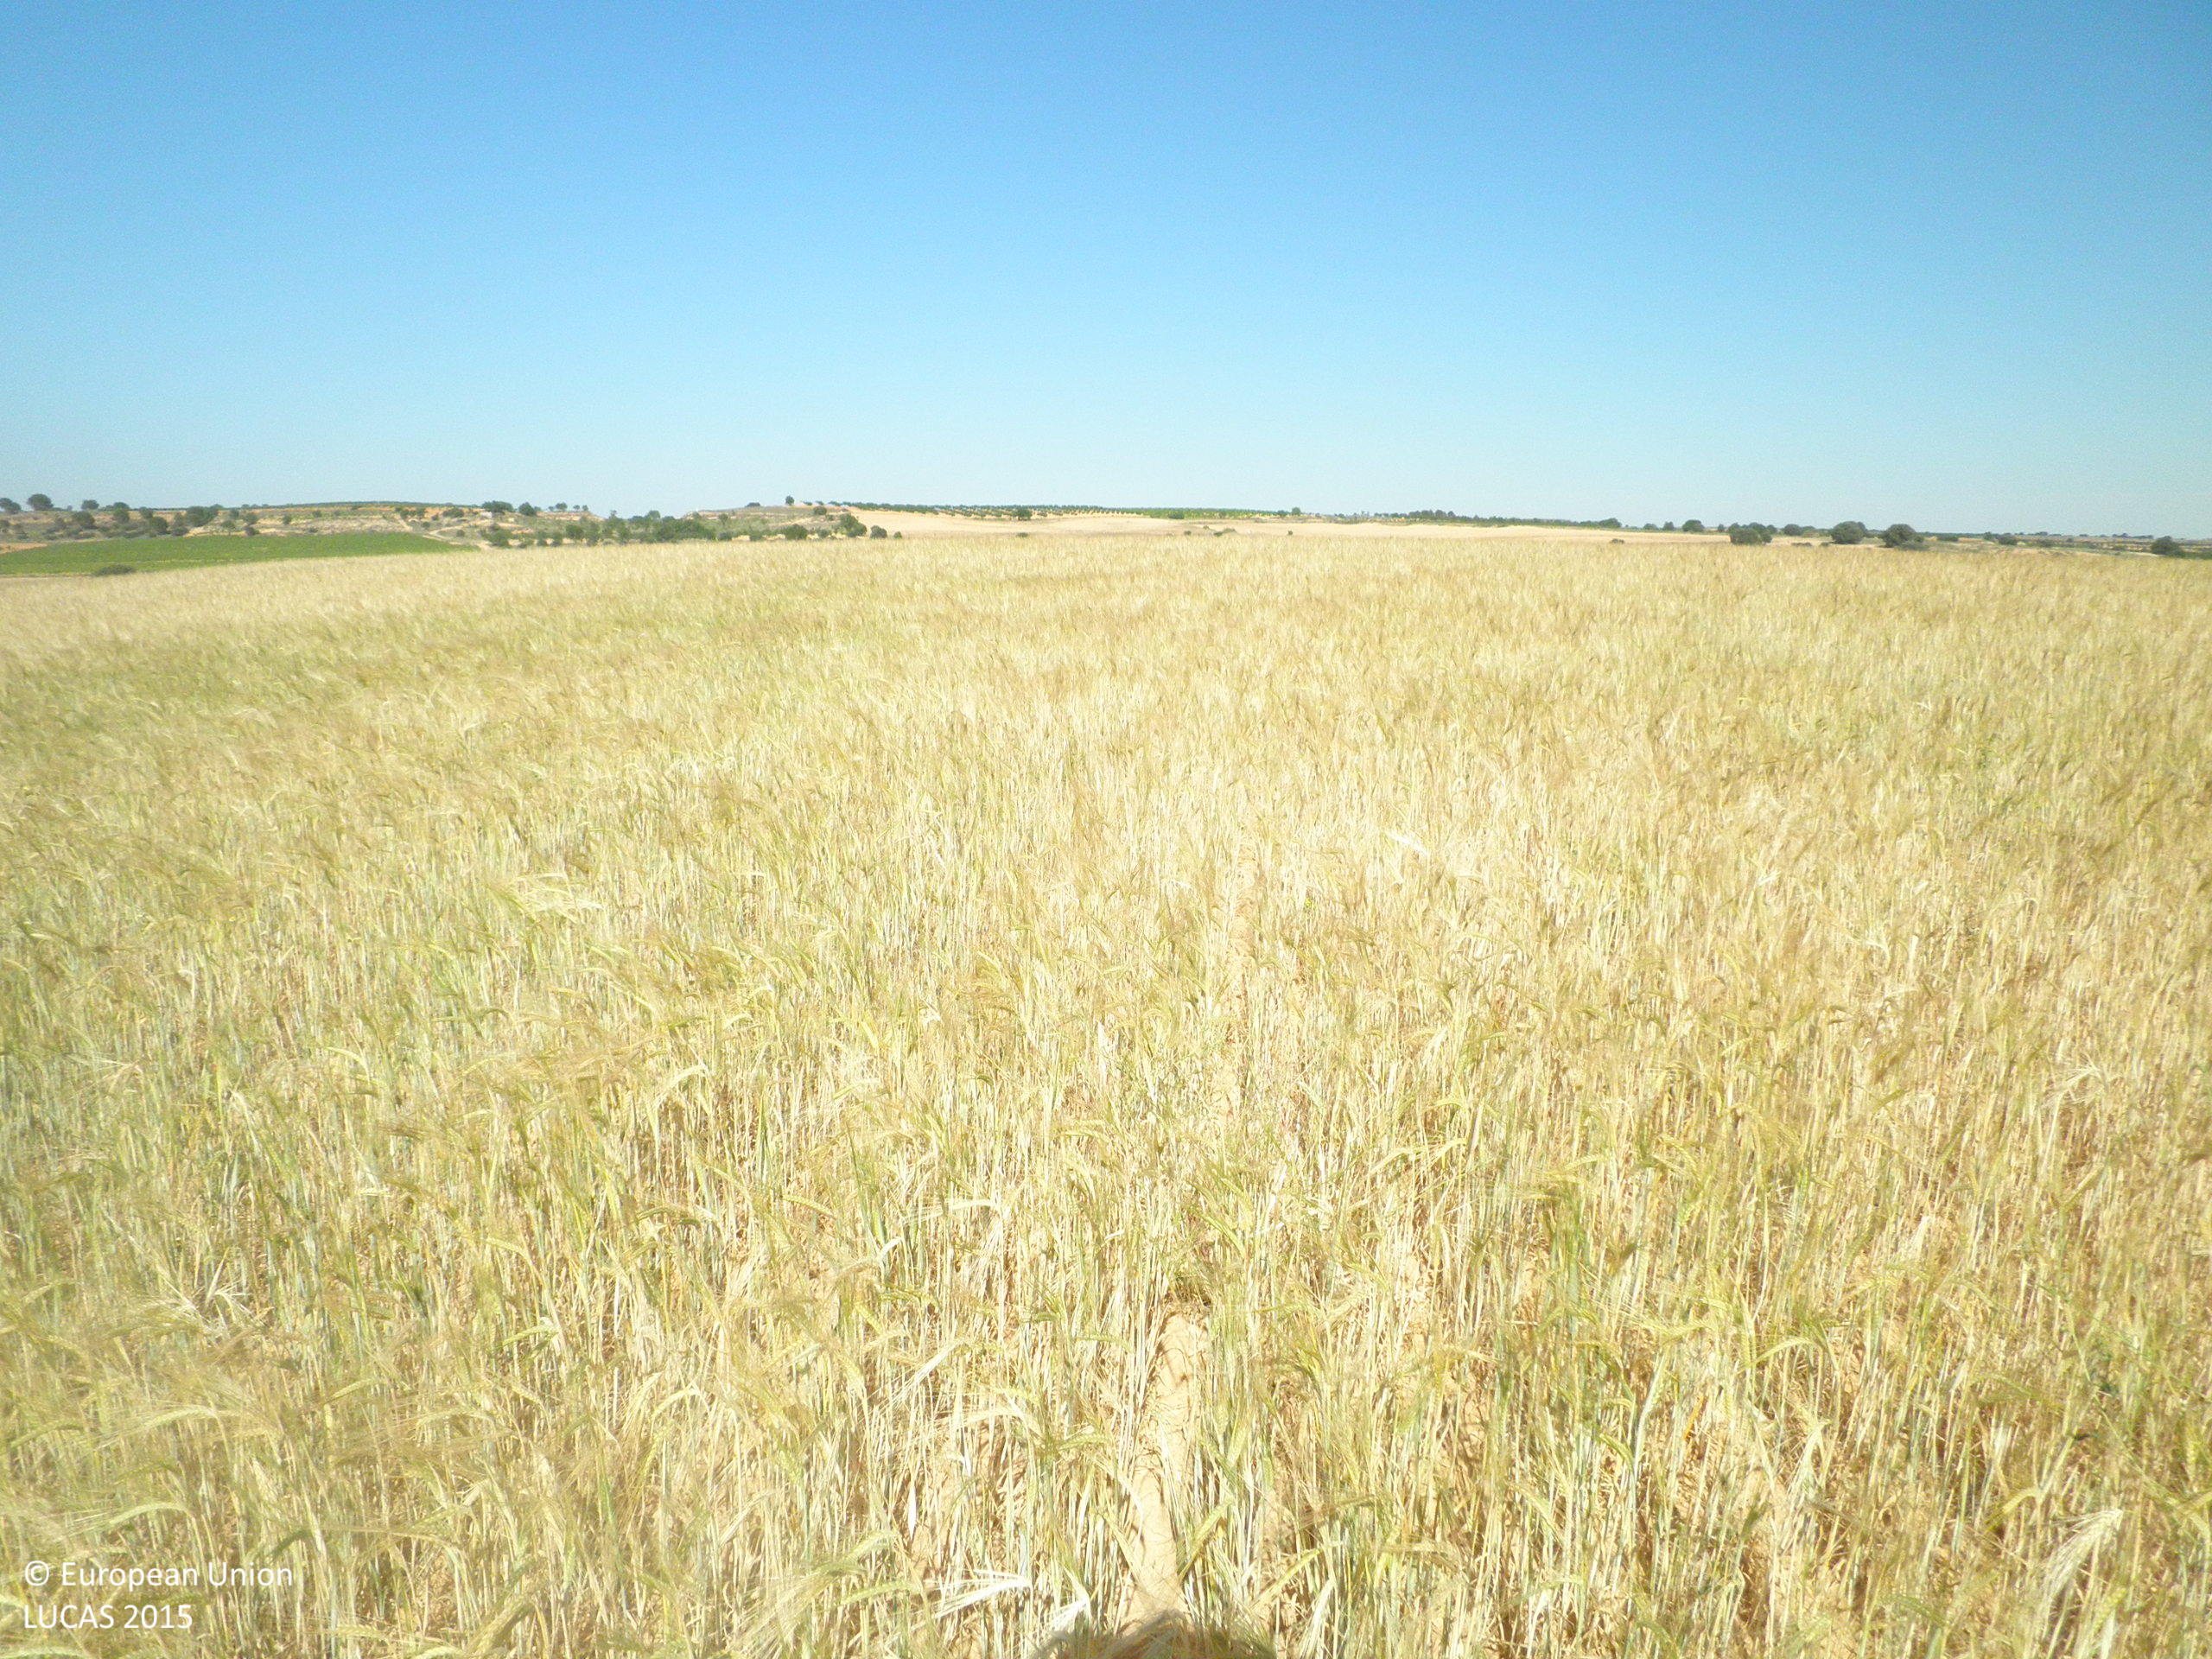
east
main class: Cropland
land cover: Barley
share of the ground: > 75 %
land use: Agriculture (excluding fallow land and kitchen gardens)
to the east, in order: Barley; Shrubland with sparse tree cover; Barley
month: June
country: ES
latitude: 39.3922
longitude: -1.7666
